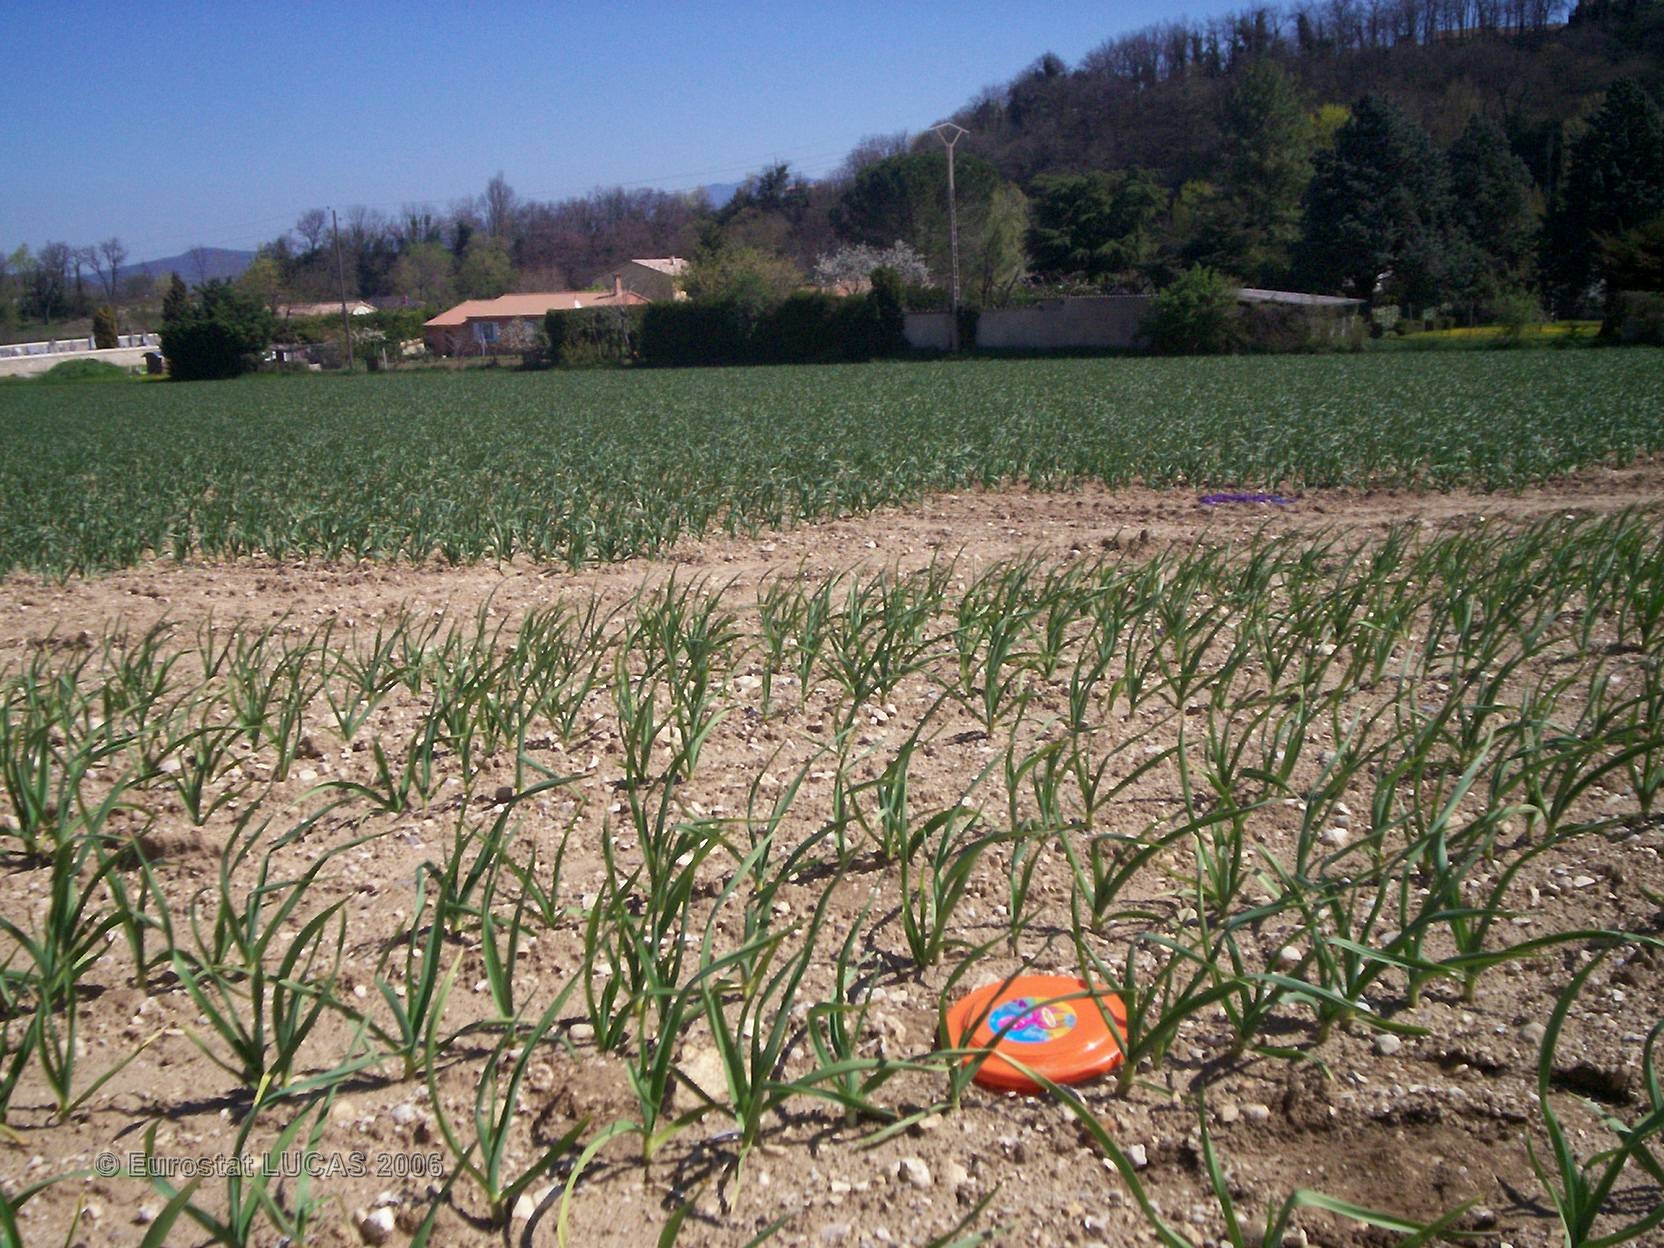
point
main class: Cropland
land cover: Other fresh vegetables
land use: Agriculture (excluding fallow land and kitchen gardens)
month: April
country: FR
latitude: 44.7319
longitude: 4.9176
